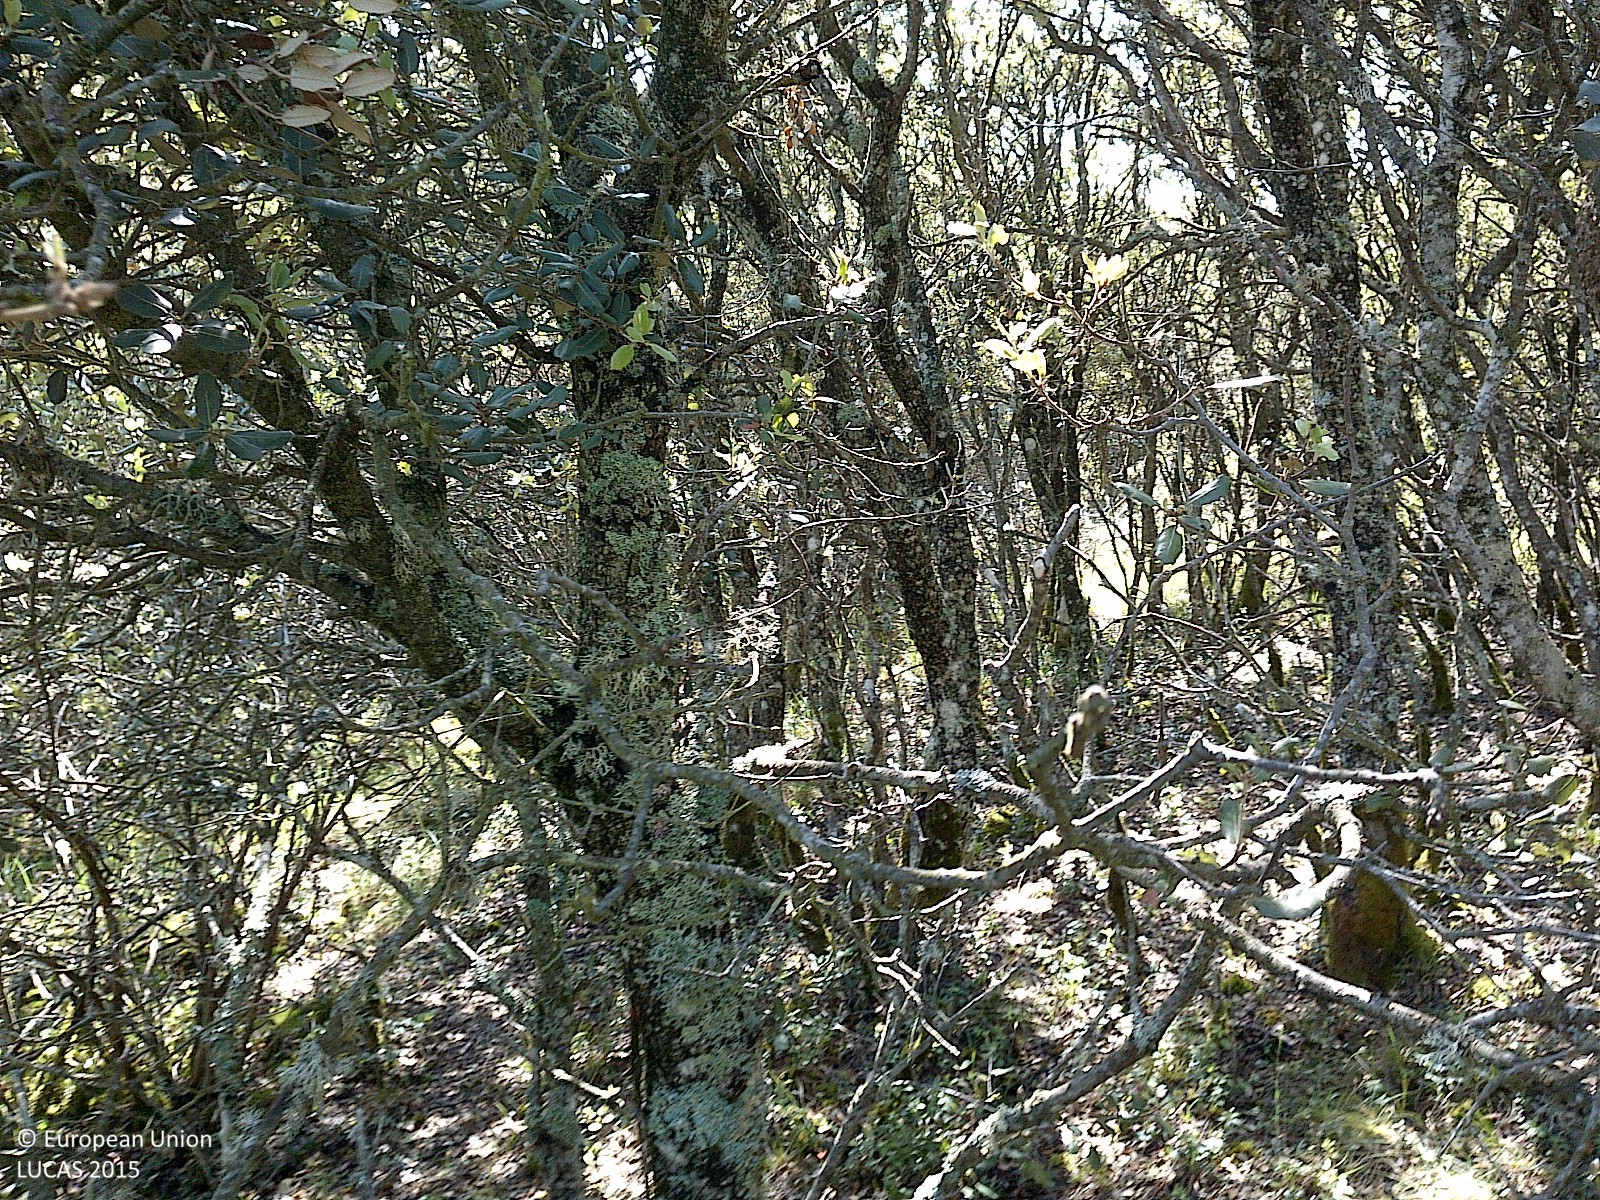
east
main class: Woodland
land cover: Broadleaved woodland
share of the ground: > 75 %
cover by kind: broadleaved forest trees 80 %, shrubs 15 %, herbaceous plants 5 %
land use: Forestry
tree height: < 5 m
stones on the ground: < 10 %
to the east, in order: Broadleaved woodland; Railways; Broadleaved woodland
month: June
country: ES
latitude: 41.8003
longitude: -2.0814
